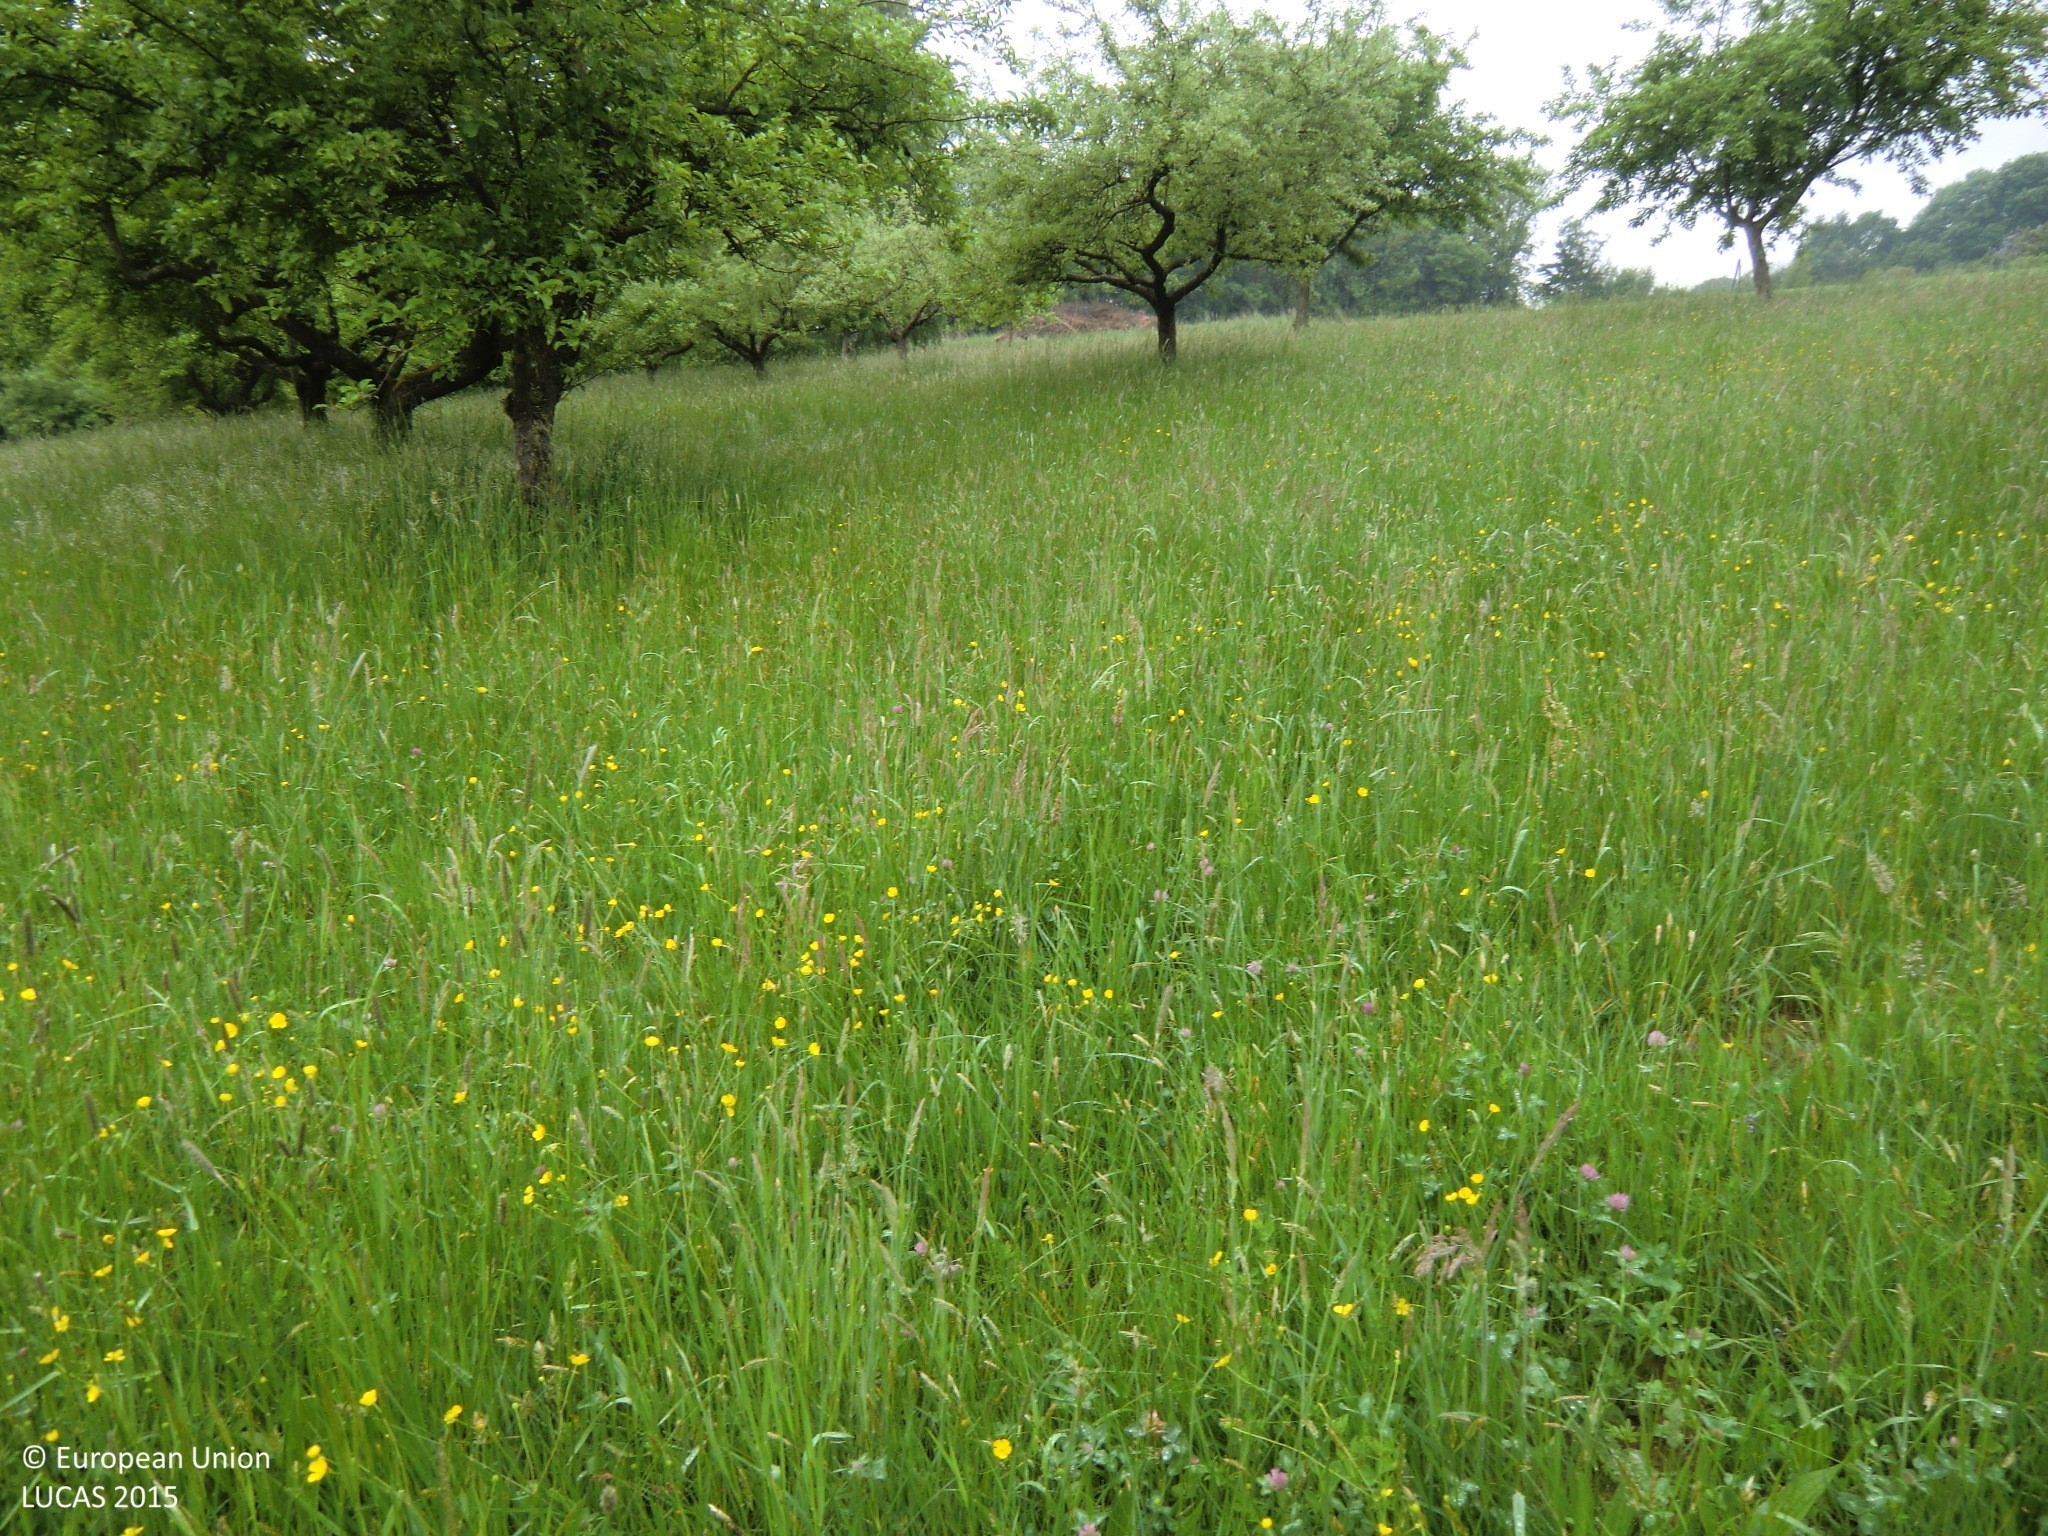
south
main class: Cropland
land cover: Apple fruit
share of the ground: 25 - 50 %
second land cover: Grassland without tree/shrub cover
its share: > 75 %
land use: Agriculture (excluding fallow land and kitchen gardens)
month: May
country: AT
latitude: 47.3190
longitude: 16.0215
